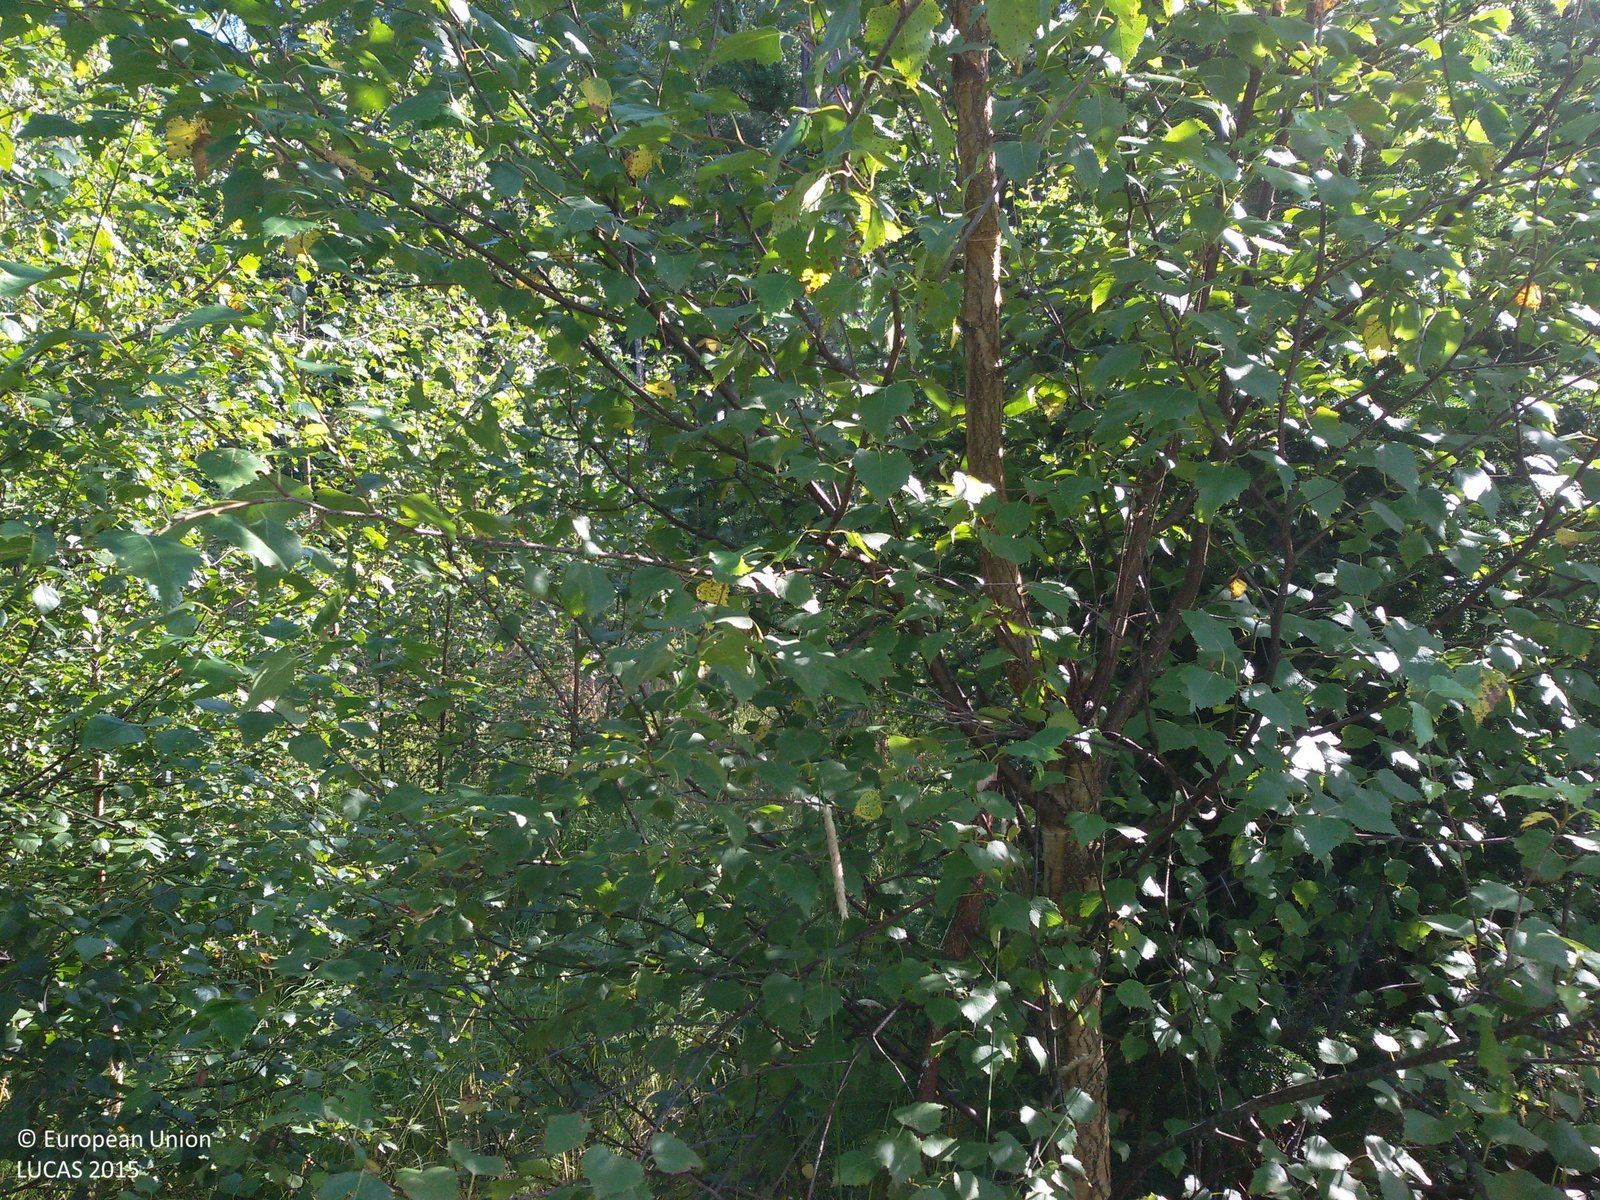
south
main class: Woodland
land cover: Pine dominated mixed woodland
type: boreal forest
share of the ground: 50 - 75 %
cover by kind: coniferous forest trees 40 %, broadleaved forest trees 30 %, herbaceous plants 30 %
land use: Forestry
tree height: < 5 m
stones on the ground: < 10 %
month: August
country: SE
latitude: 60.6250
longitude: 16.5491
